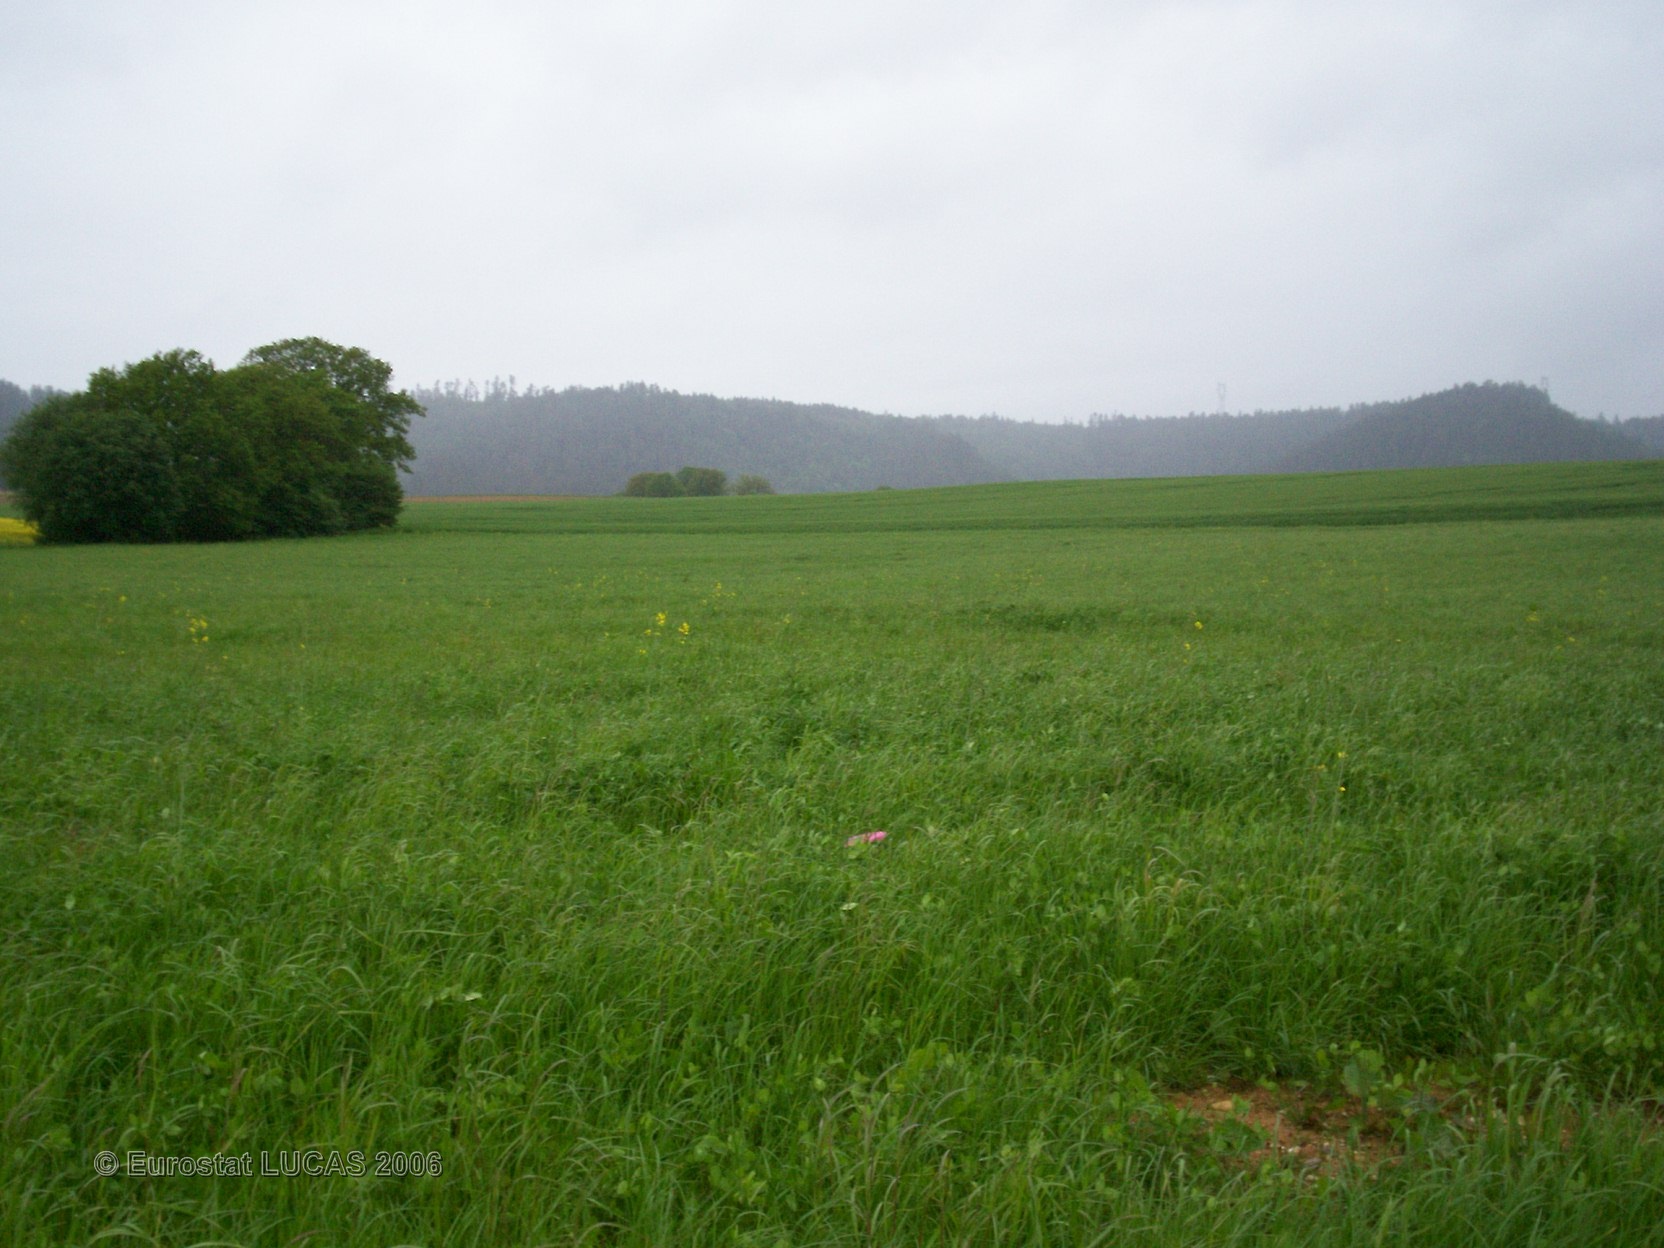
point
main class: Cropland
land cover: Other leguminous and mixtures for fodder
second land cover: Clovers
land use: Agriculture (excluding fallow land and kitchen gardens)
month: May
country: FR
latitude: 48.1947
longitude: 6.7856
